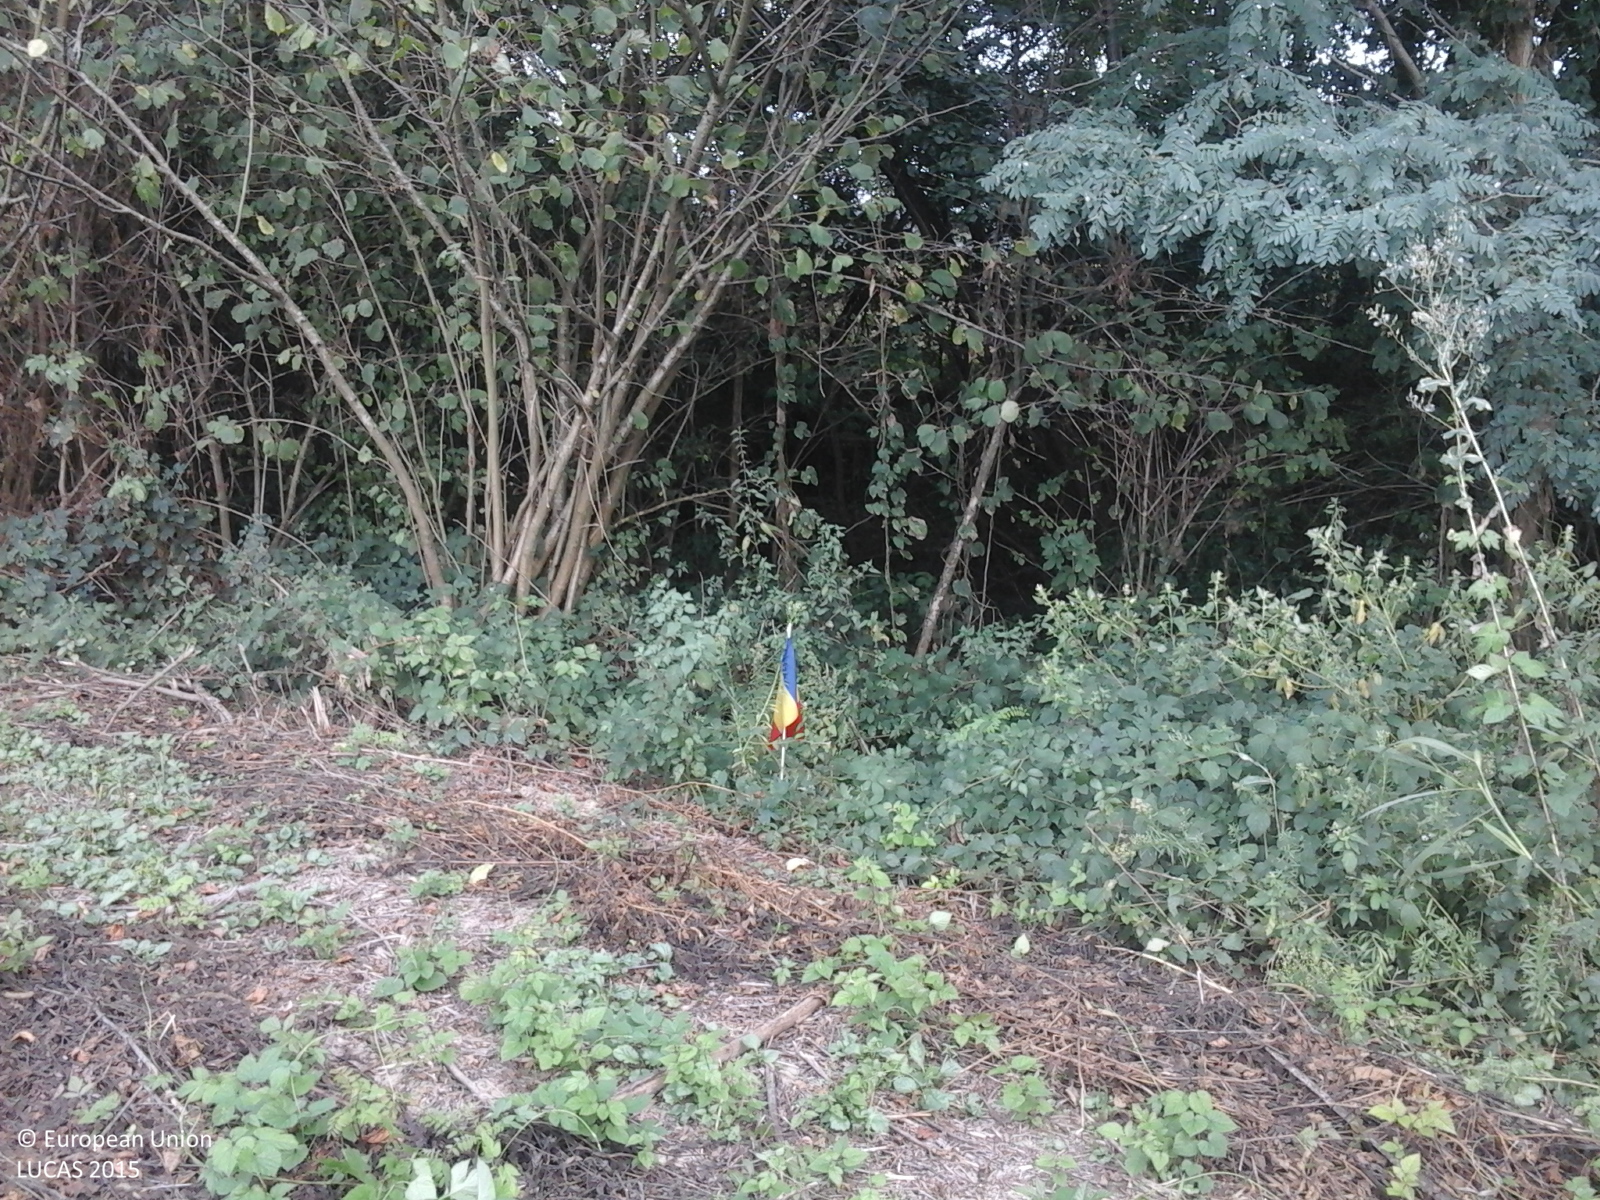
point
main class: Woodland
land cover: Broadleaved woodland
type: non-riverine alder, birch or aspen forest
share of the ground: > 75 %
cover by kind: broadleaved forest trees 100 %
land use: Forestry
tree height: > 5 m
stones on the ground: < 10 %
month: August
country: RO
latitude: 46.2626
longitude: 22.2550
